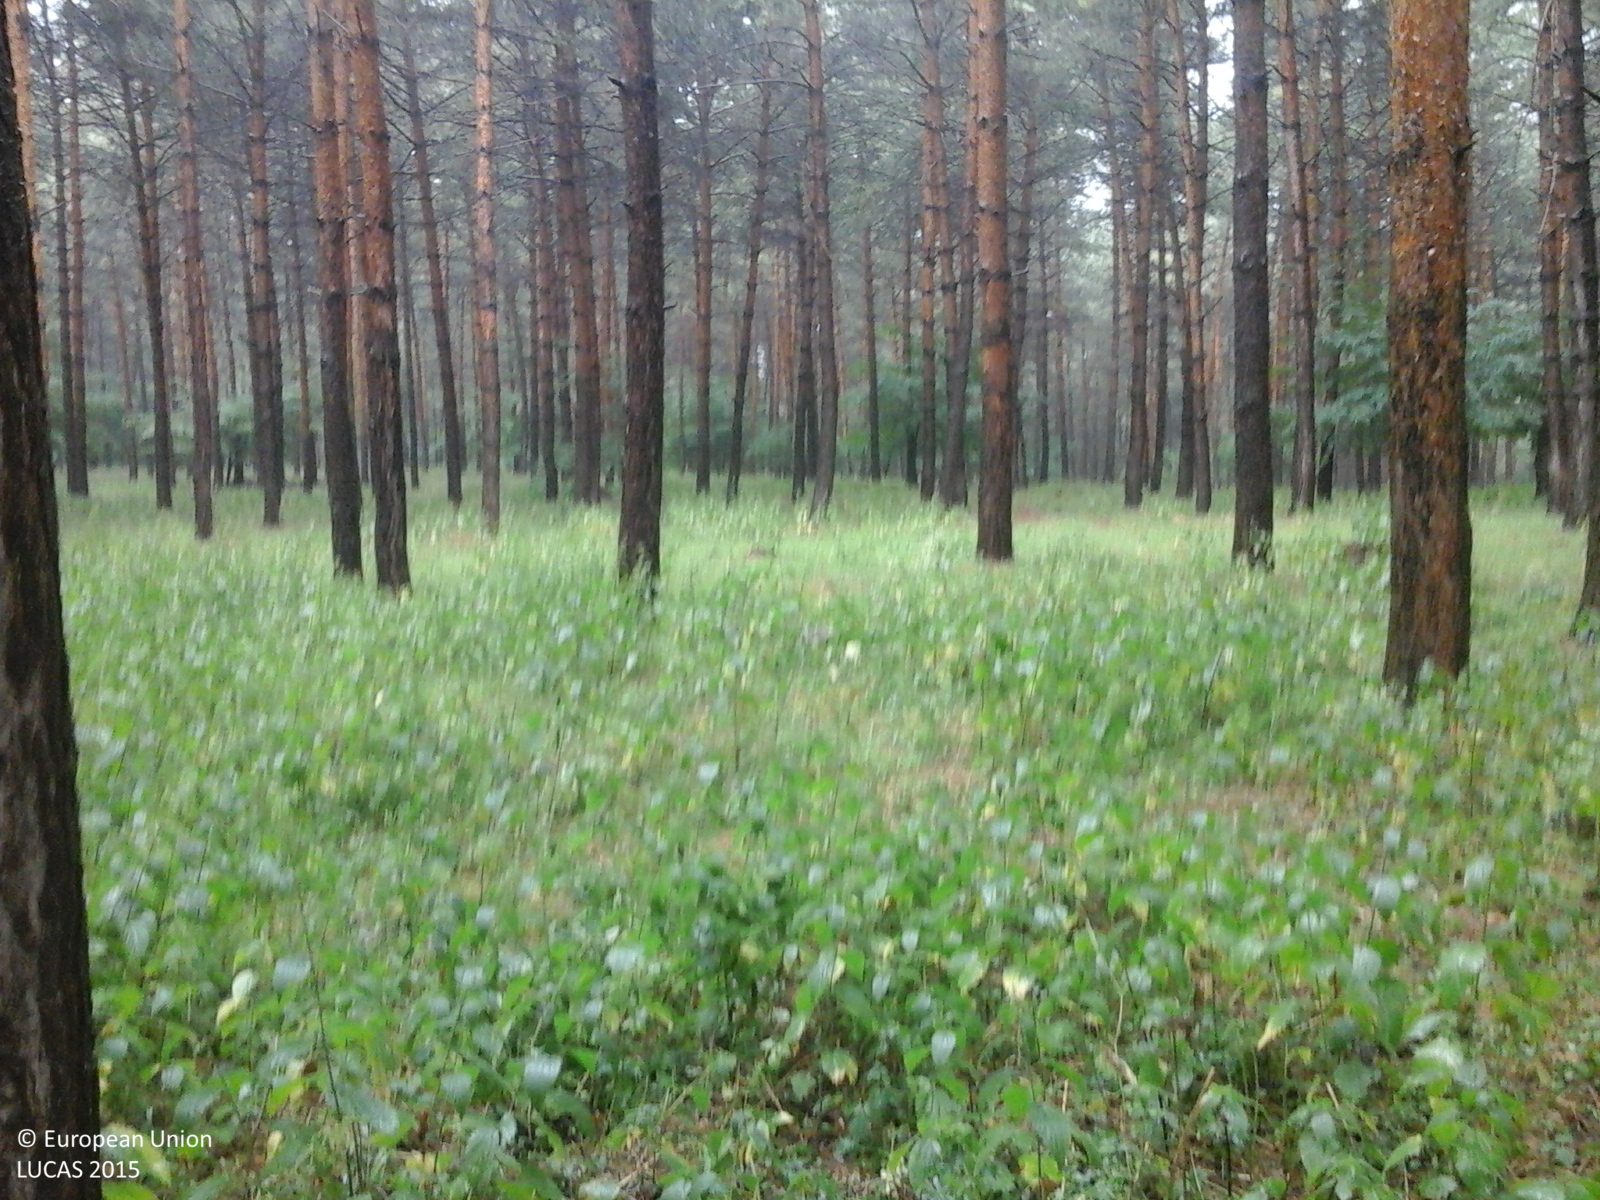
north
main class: Woodland
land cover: Pine dominated coniferous woodland
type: hemiboreal forest and nemoral coniferous forest and mixed broadleaved-coniferous forest
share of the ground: > 75 %
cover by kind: coniferous forest trees 95 %, broadleaved forest trees 5 %
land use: Forestry
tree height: > 5 m
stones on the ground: 10 - 25 %
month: June
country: RO
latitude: 47.3908
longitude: 26.8567
